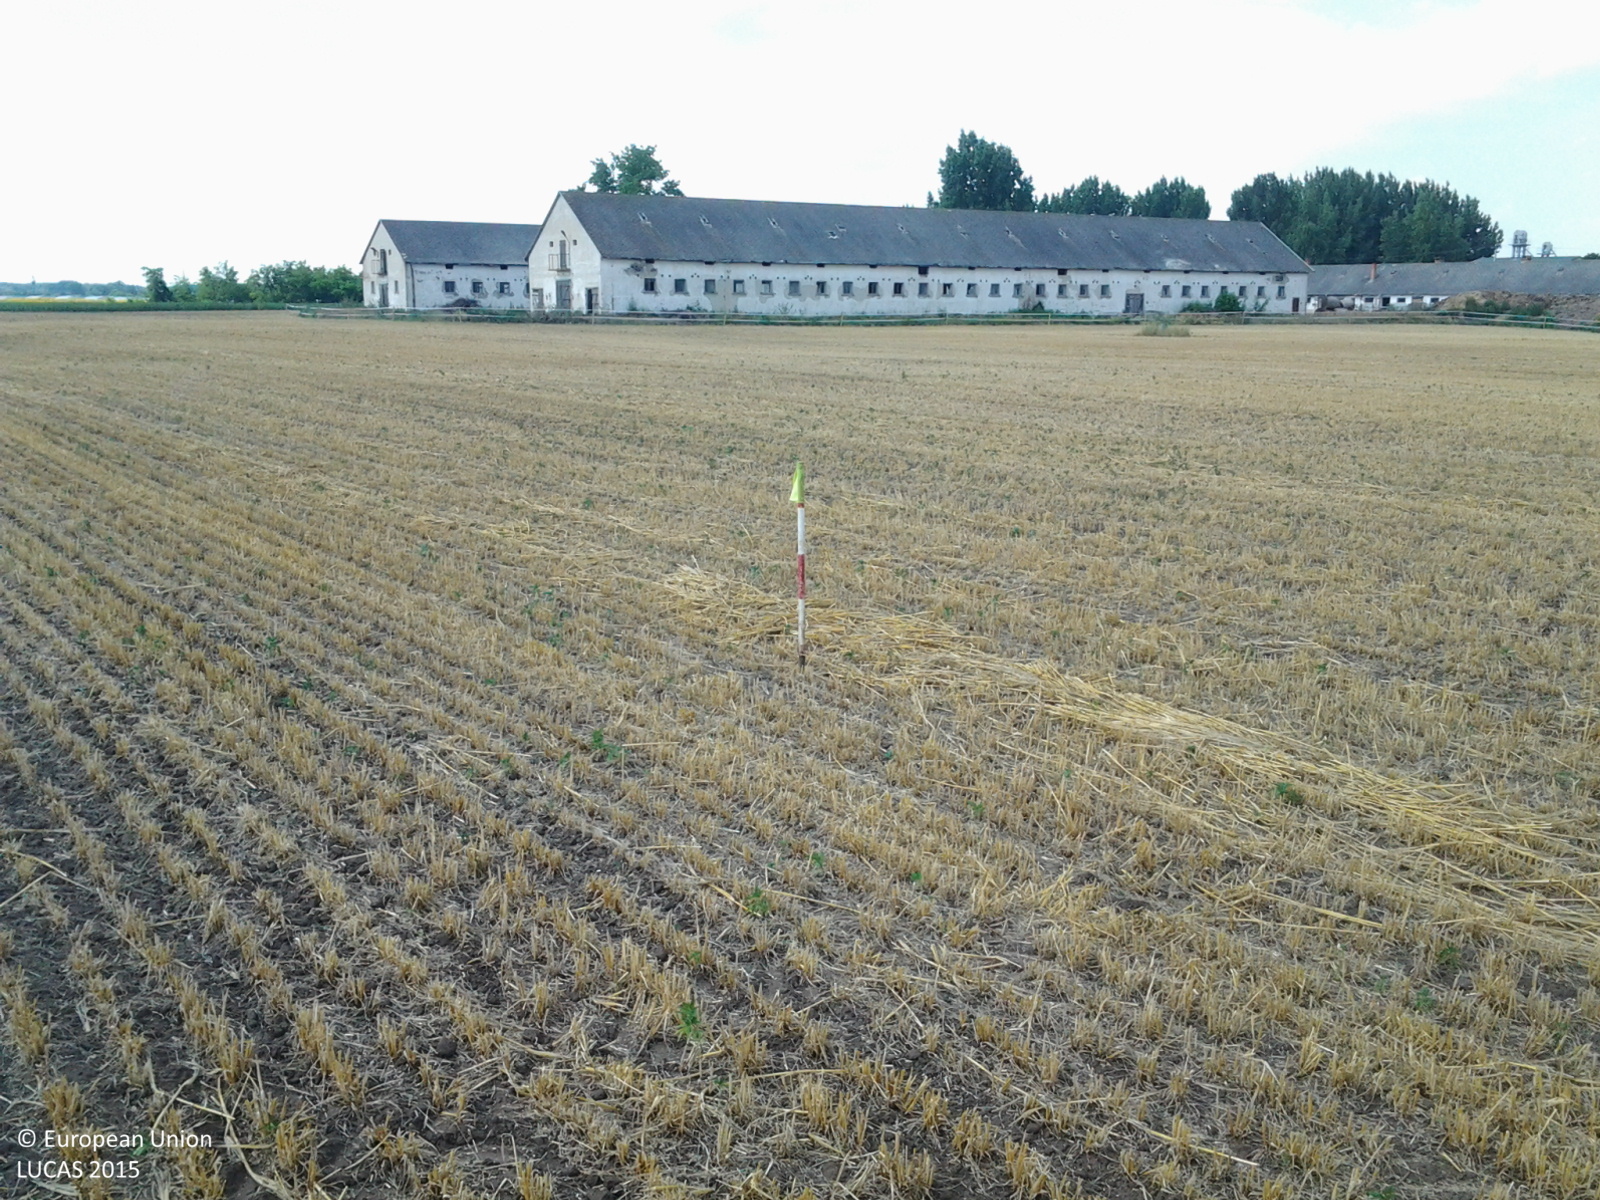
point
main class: Cropland
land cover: Barley
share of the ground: > 75 %
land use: Agriculture (excluding fallow land and kitchen gardens)
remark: Harvested field
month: July
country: HU
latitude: 47.4952
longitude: 19.8071
